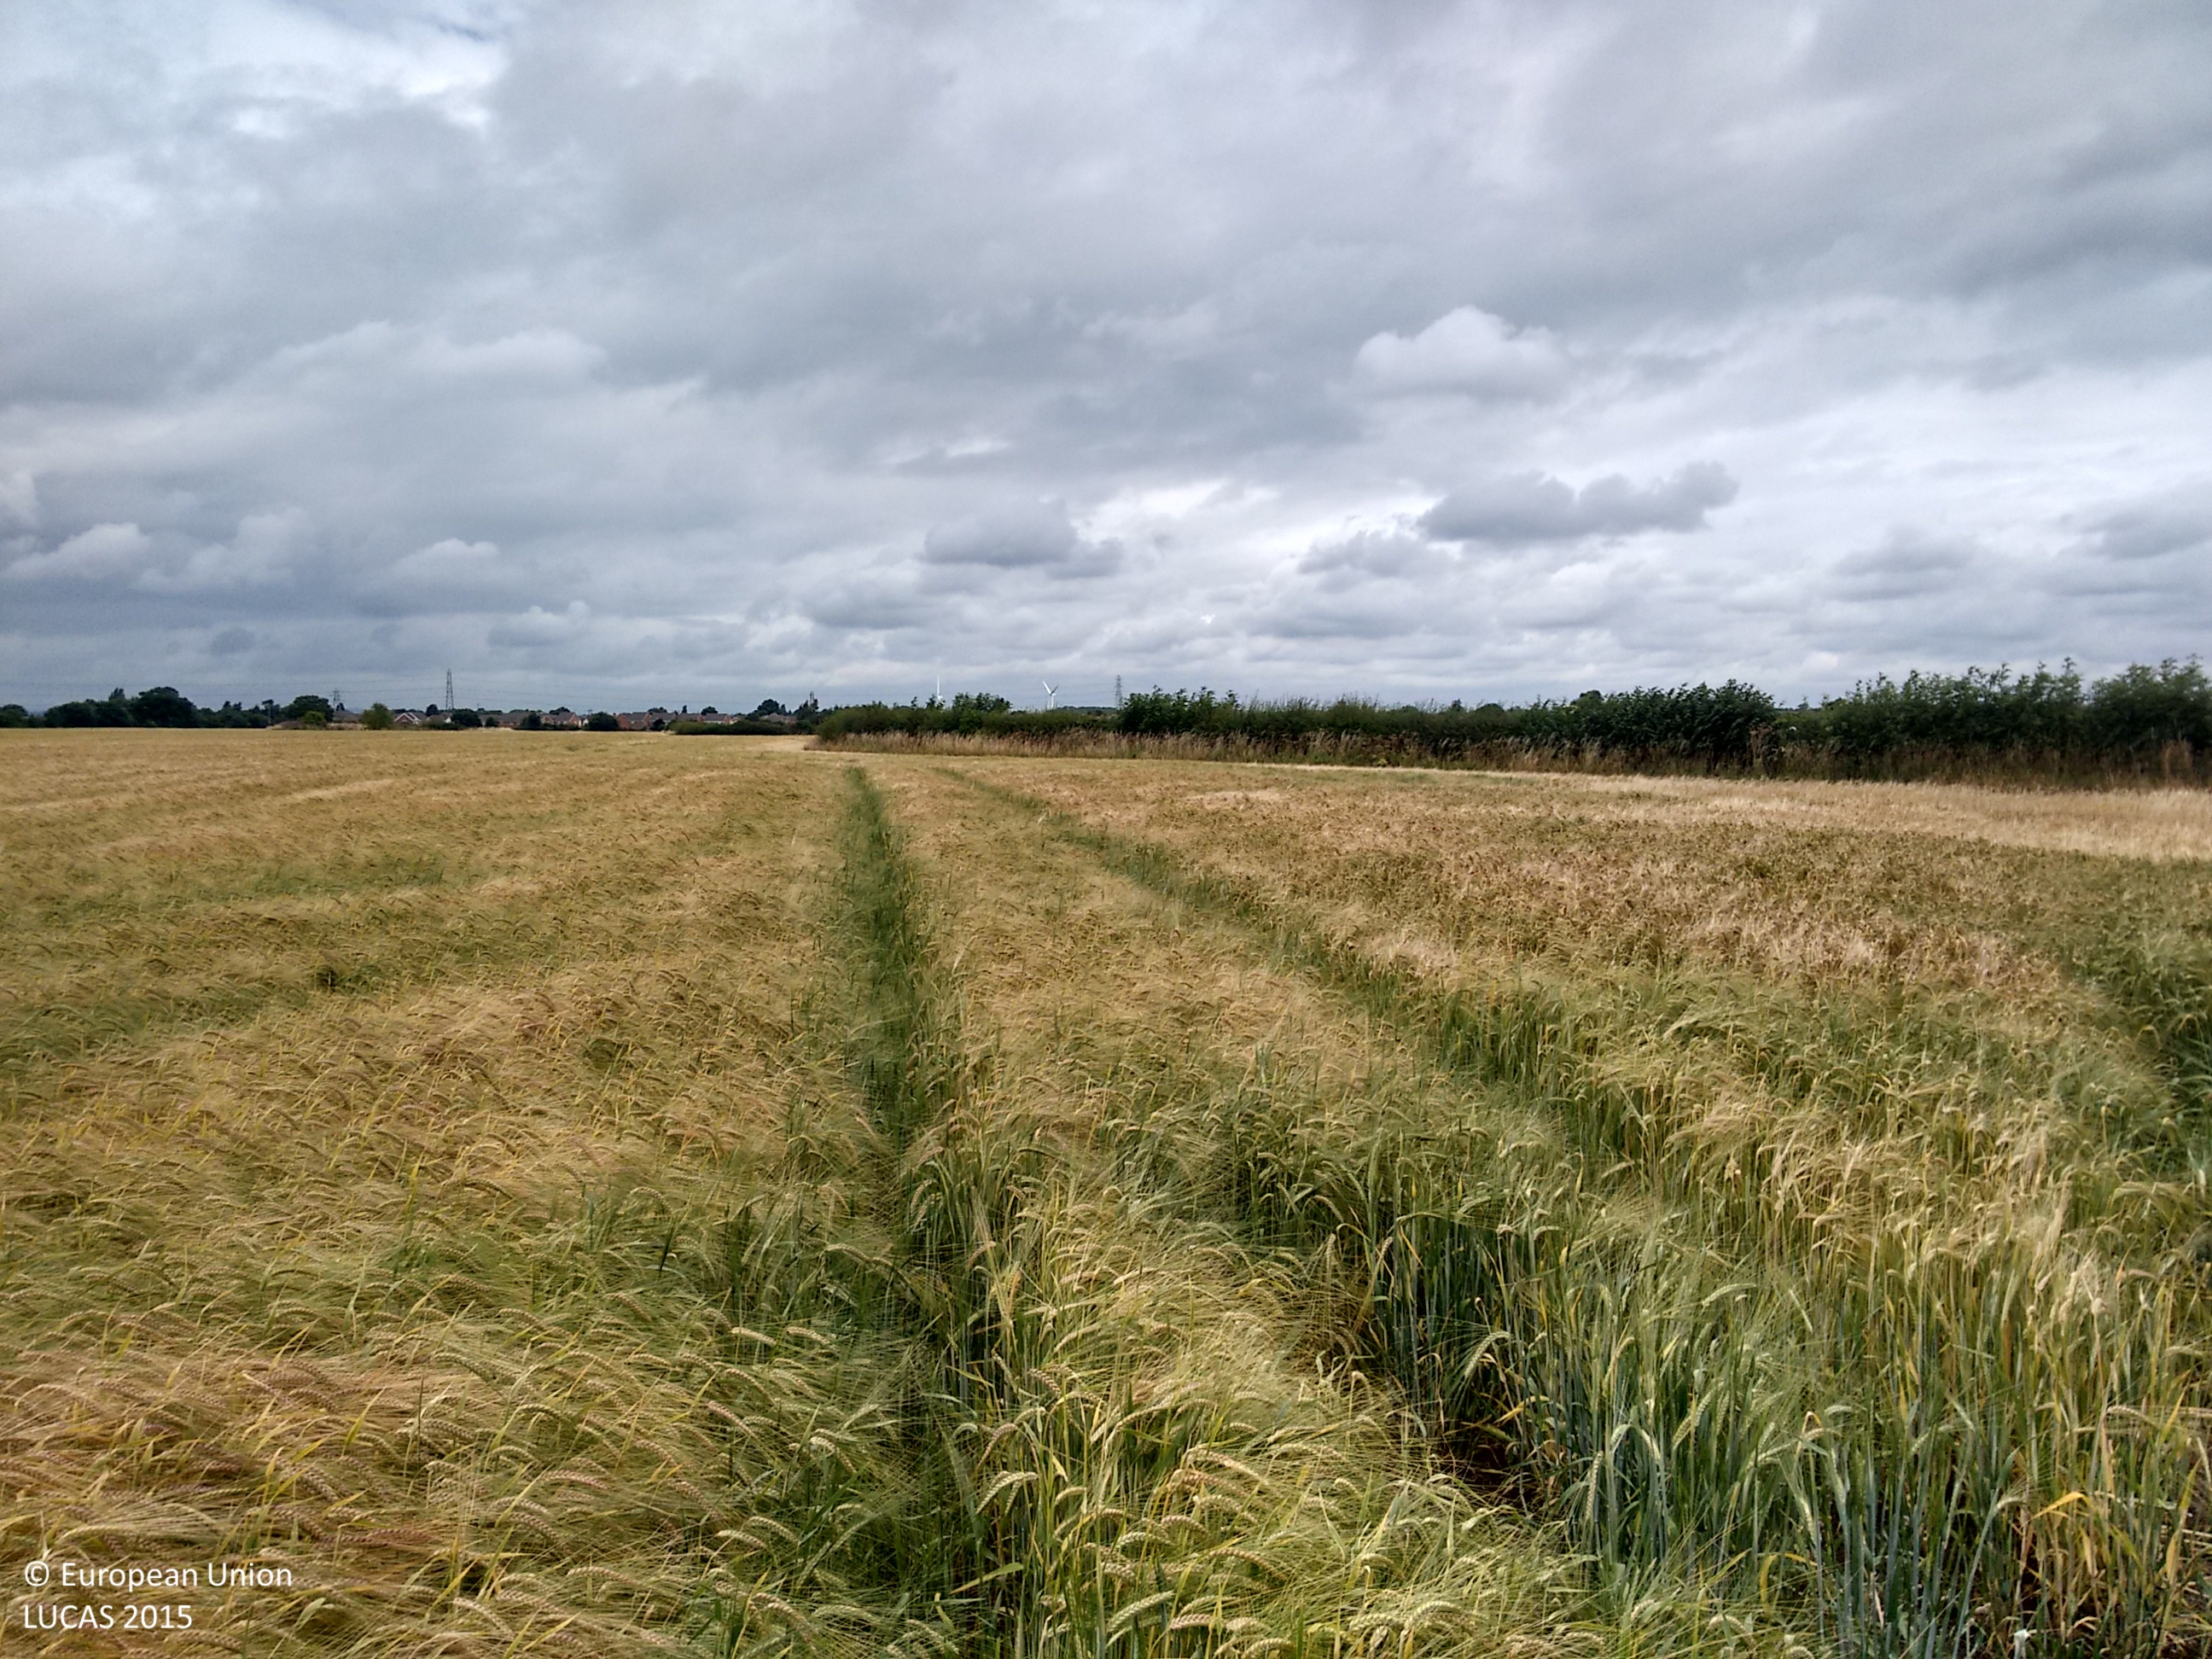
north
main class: Cropland
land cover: Barley
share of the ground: > 75 %
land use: Agriculture (excluding fallow land and kitchen gardens)
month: July
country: GB
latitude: 52.8781
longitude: -1.4165
